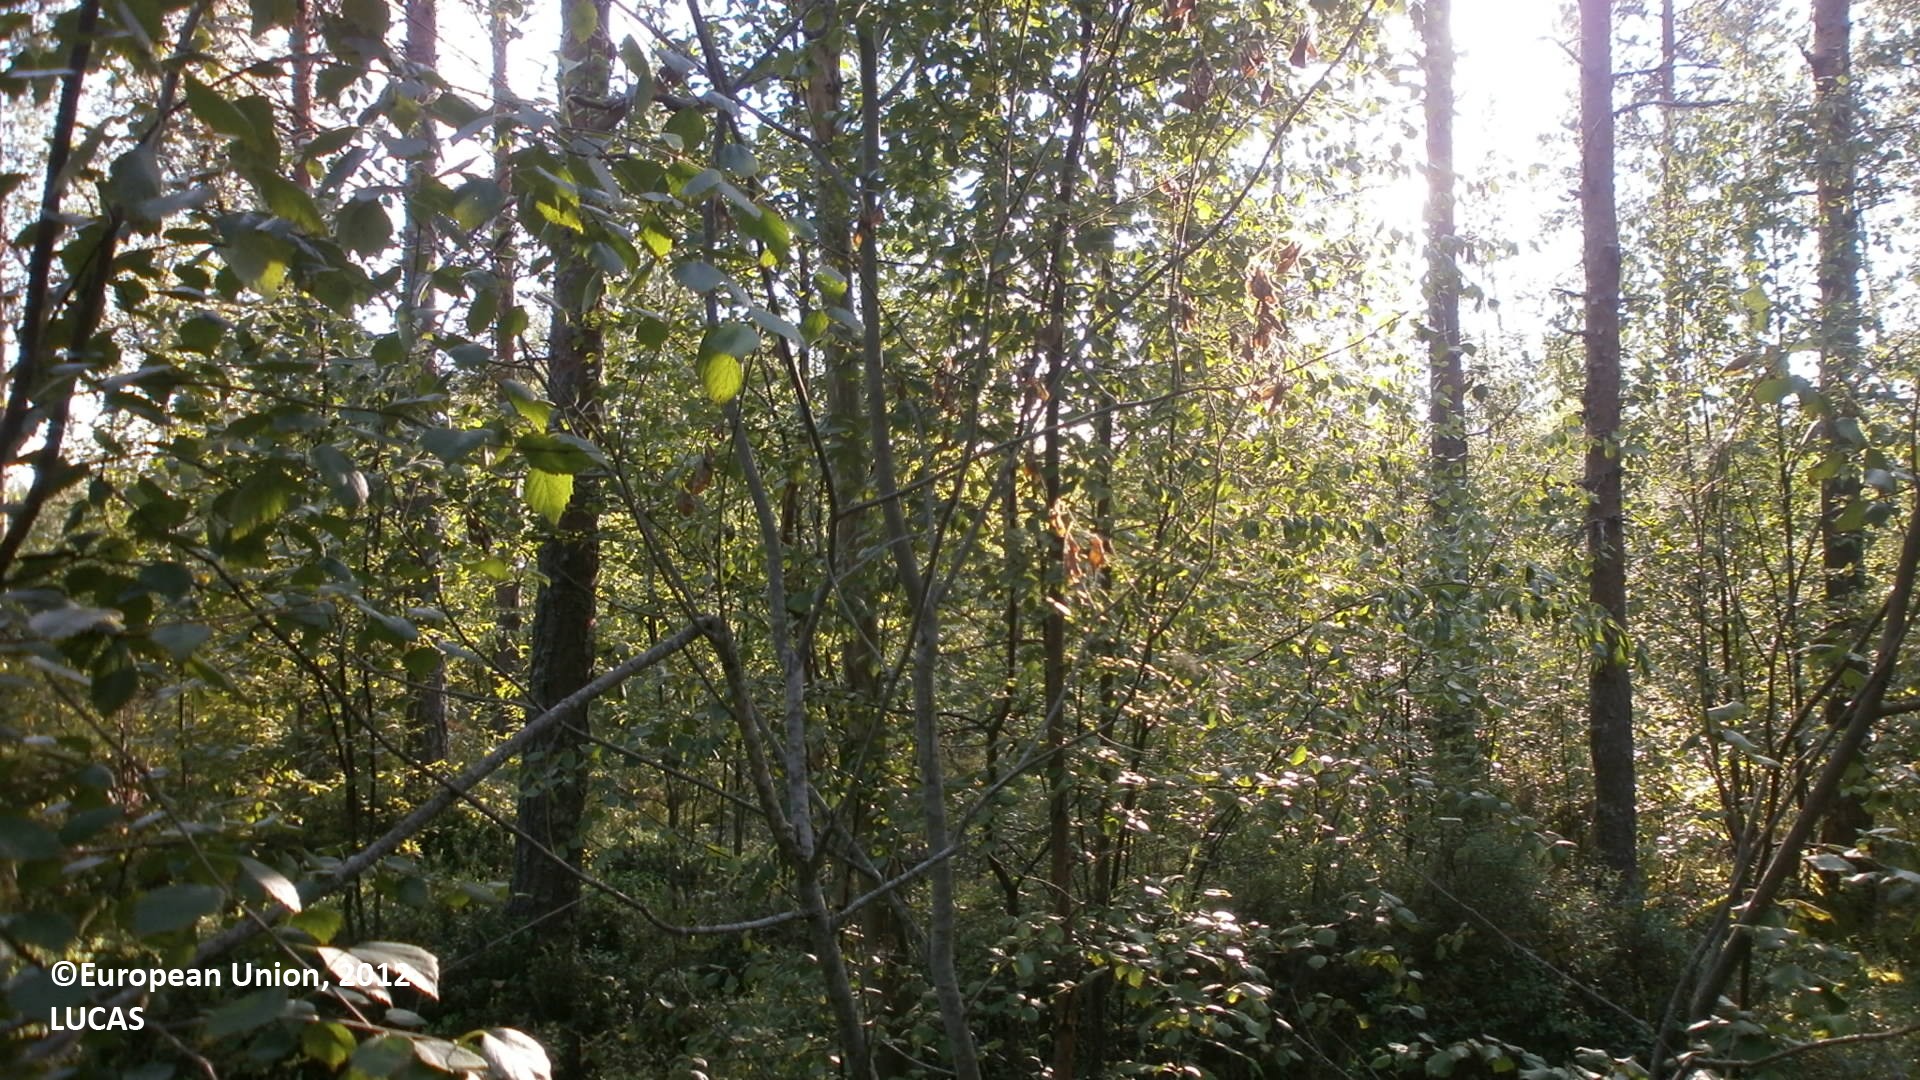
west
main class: Woodland
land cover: Pine dominated mixed woodland
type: boreal forest
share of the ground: > 75 %
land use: Forestry
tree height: > 5 m
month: July
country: FI
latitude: 64.0758
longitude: 24.3189
